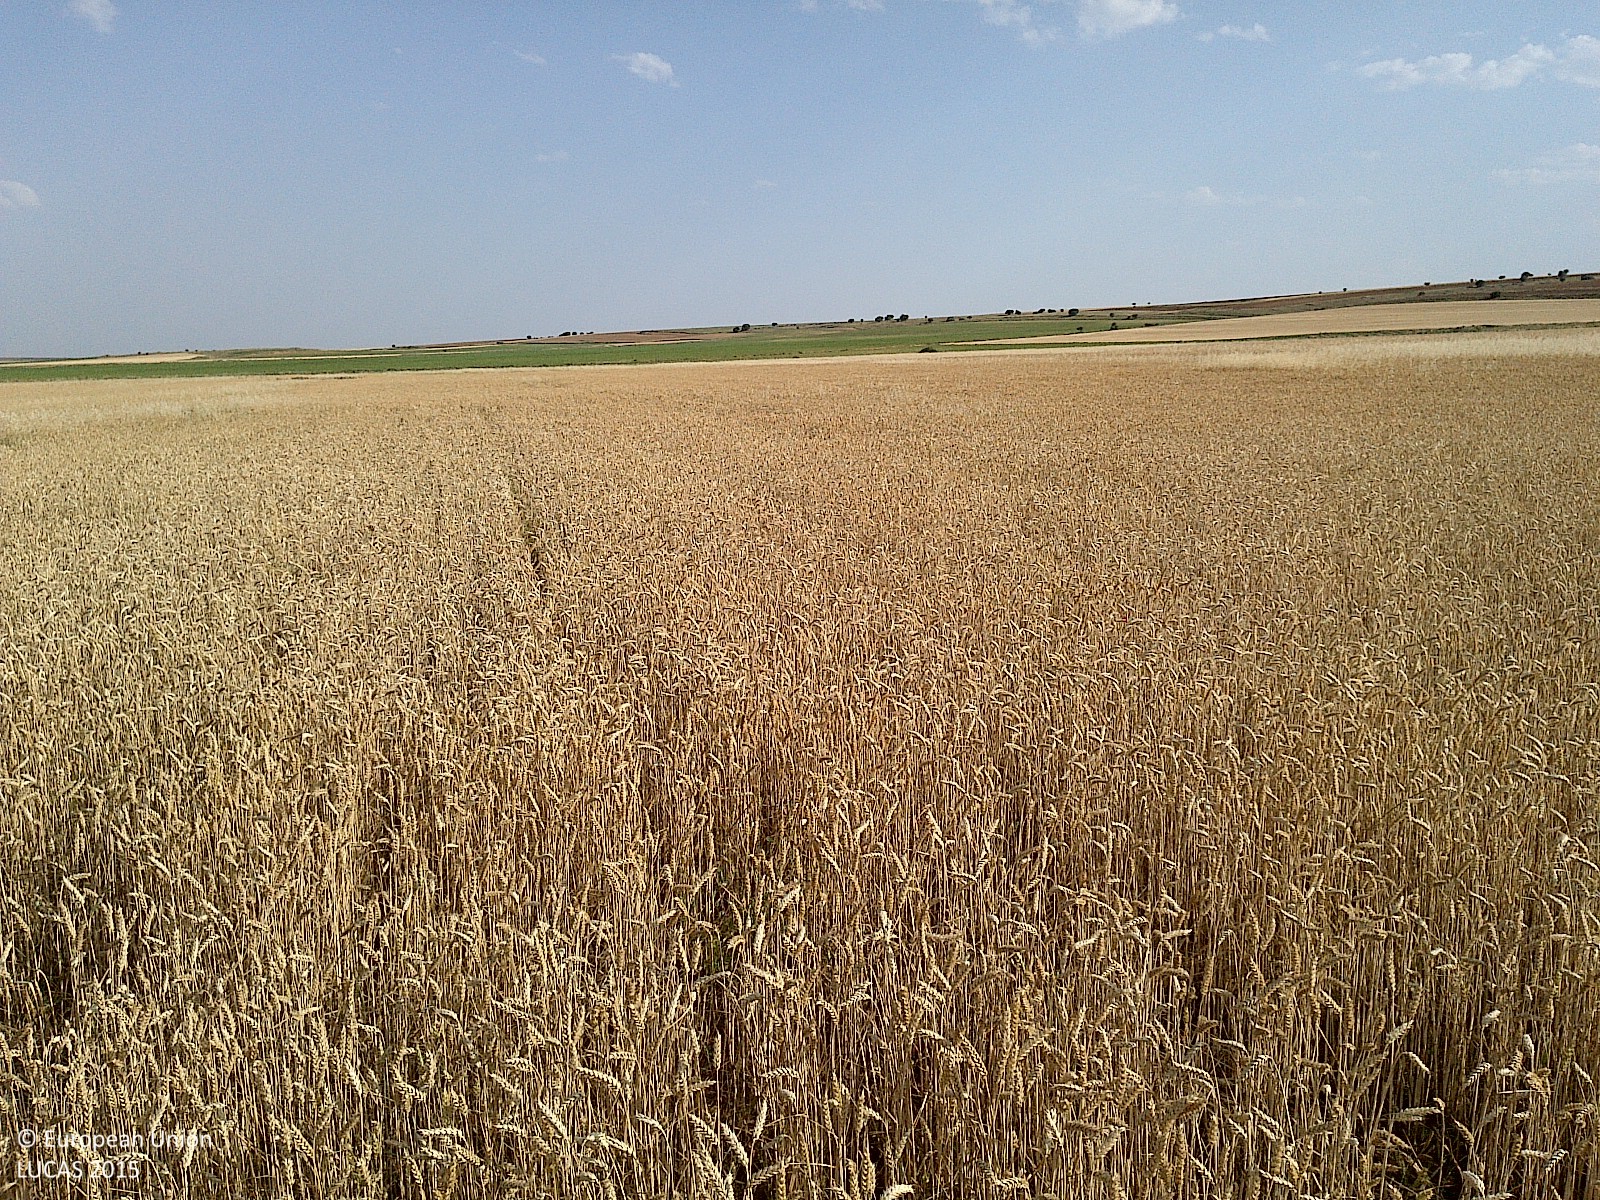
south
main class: Cropland
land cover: Common wheat
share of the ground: > 75 %
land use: Agriculture (excluding fallow land and kitchen gardens)
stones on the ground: < 10 %
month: June
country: ES
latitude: 41.6255
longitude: -2.1679
